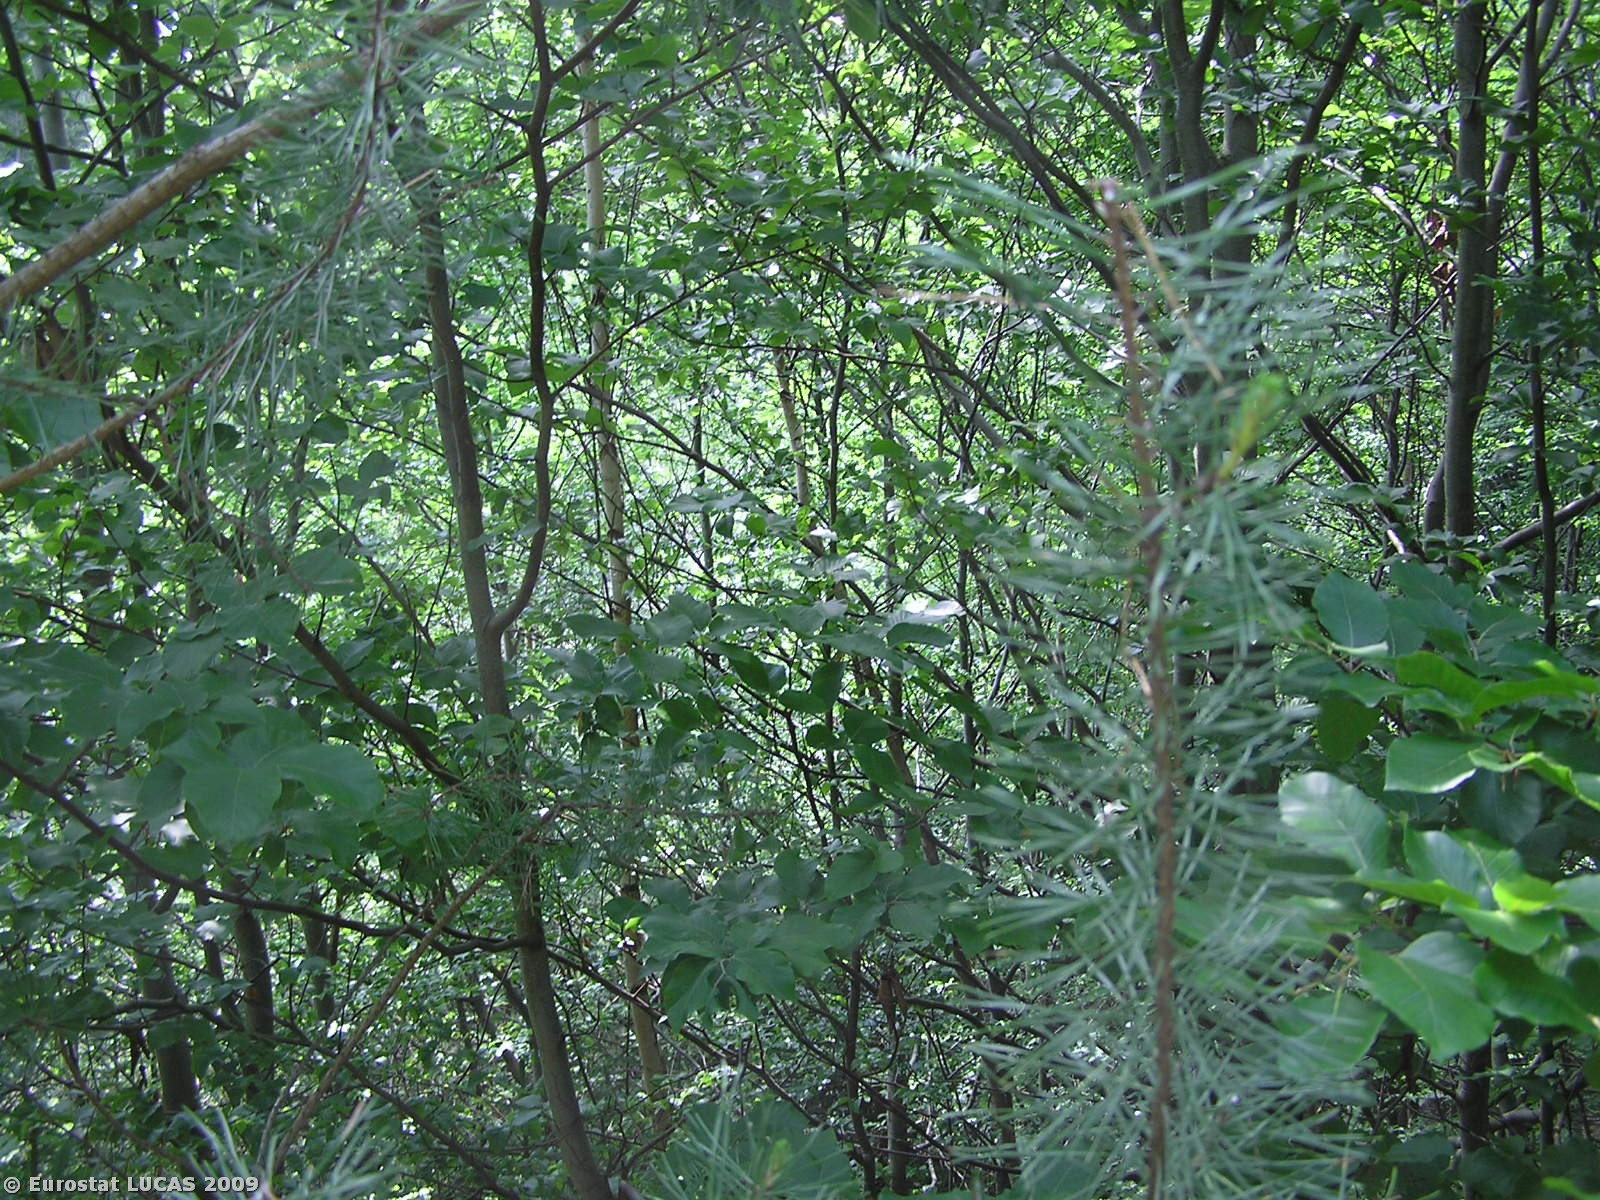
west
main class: Woodland
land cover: Mixed woodland
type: hemiboreal forest and nemoral coniferous forest and mixed broadleaved-coniferous forest
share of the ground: > 75 %
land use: Forestry
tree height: > 5 m
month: June
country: CZ
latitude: 49.8634
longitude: 14.8854
